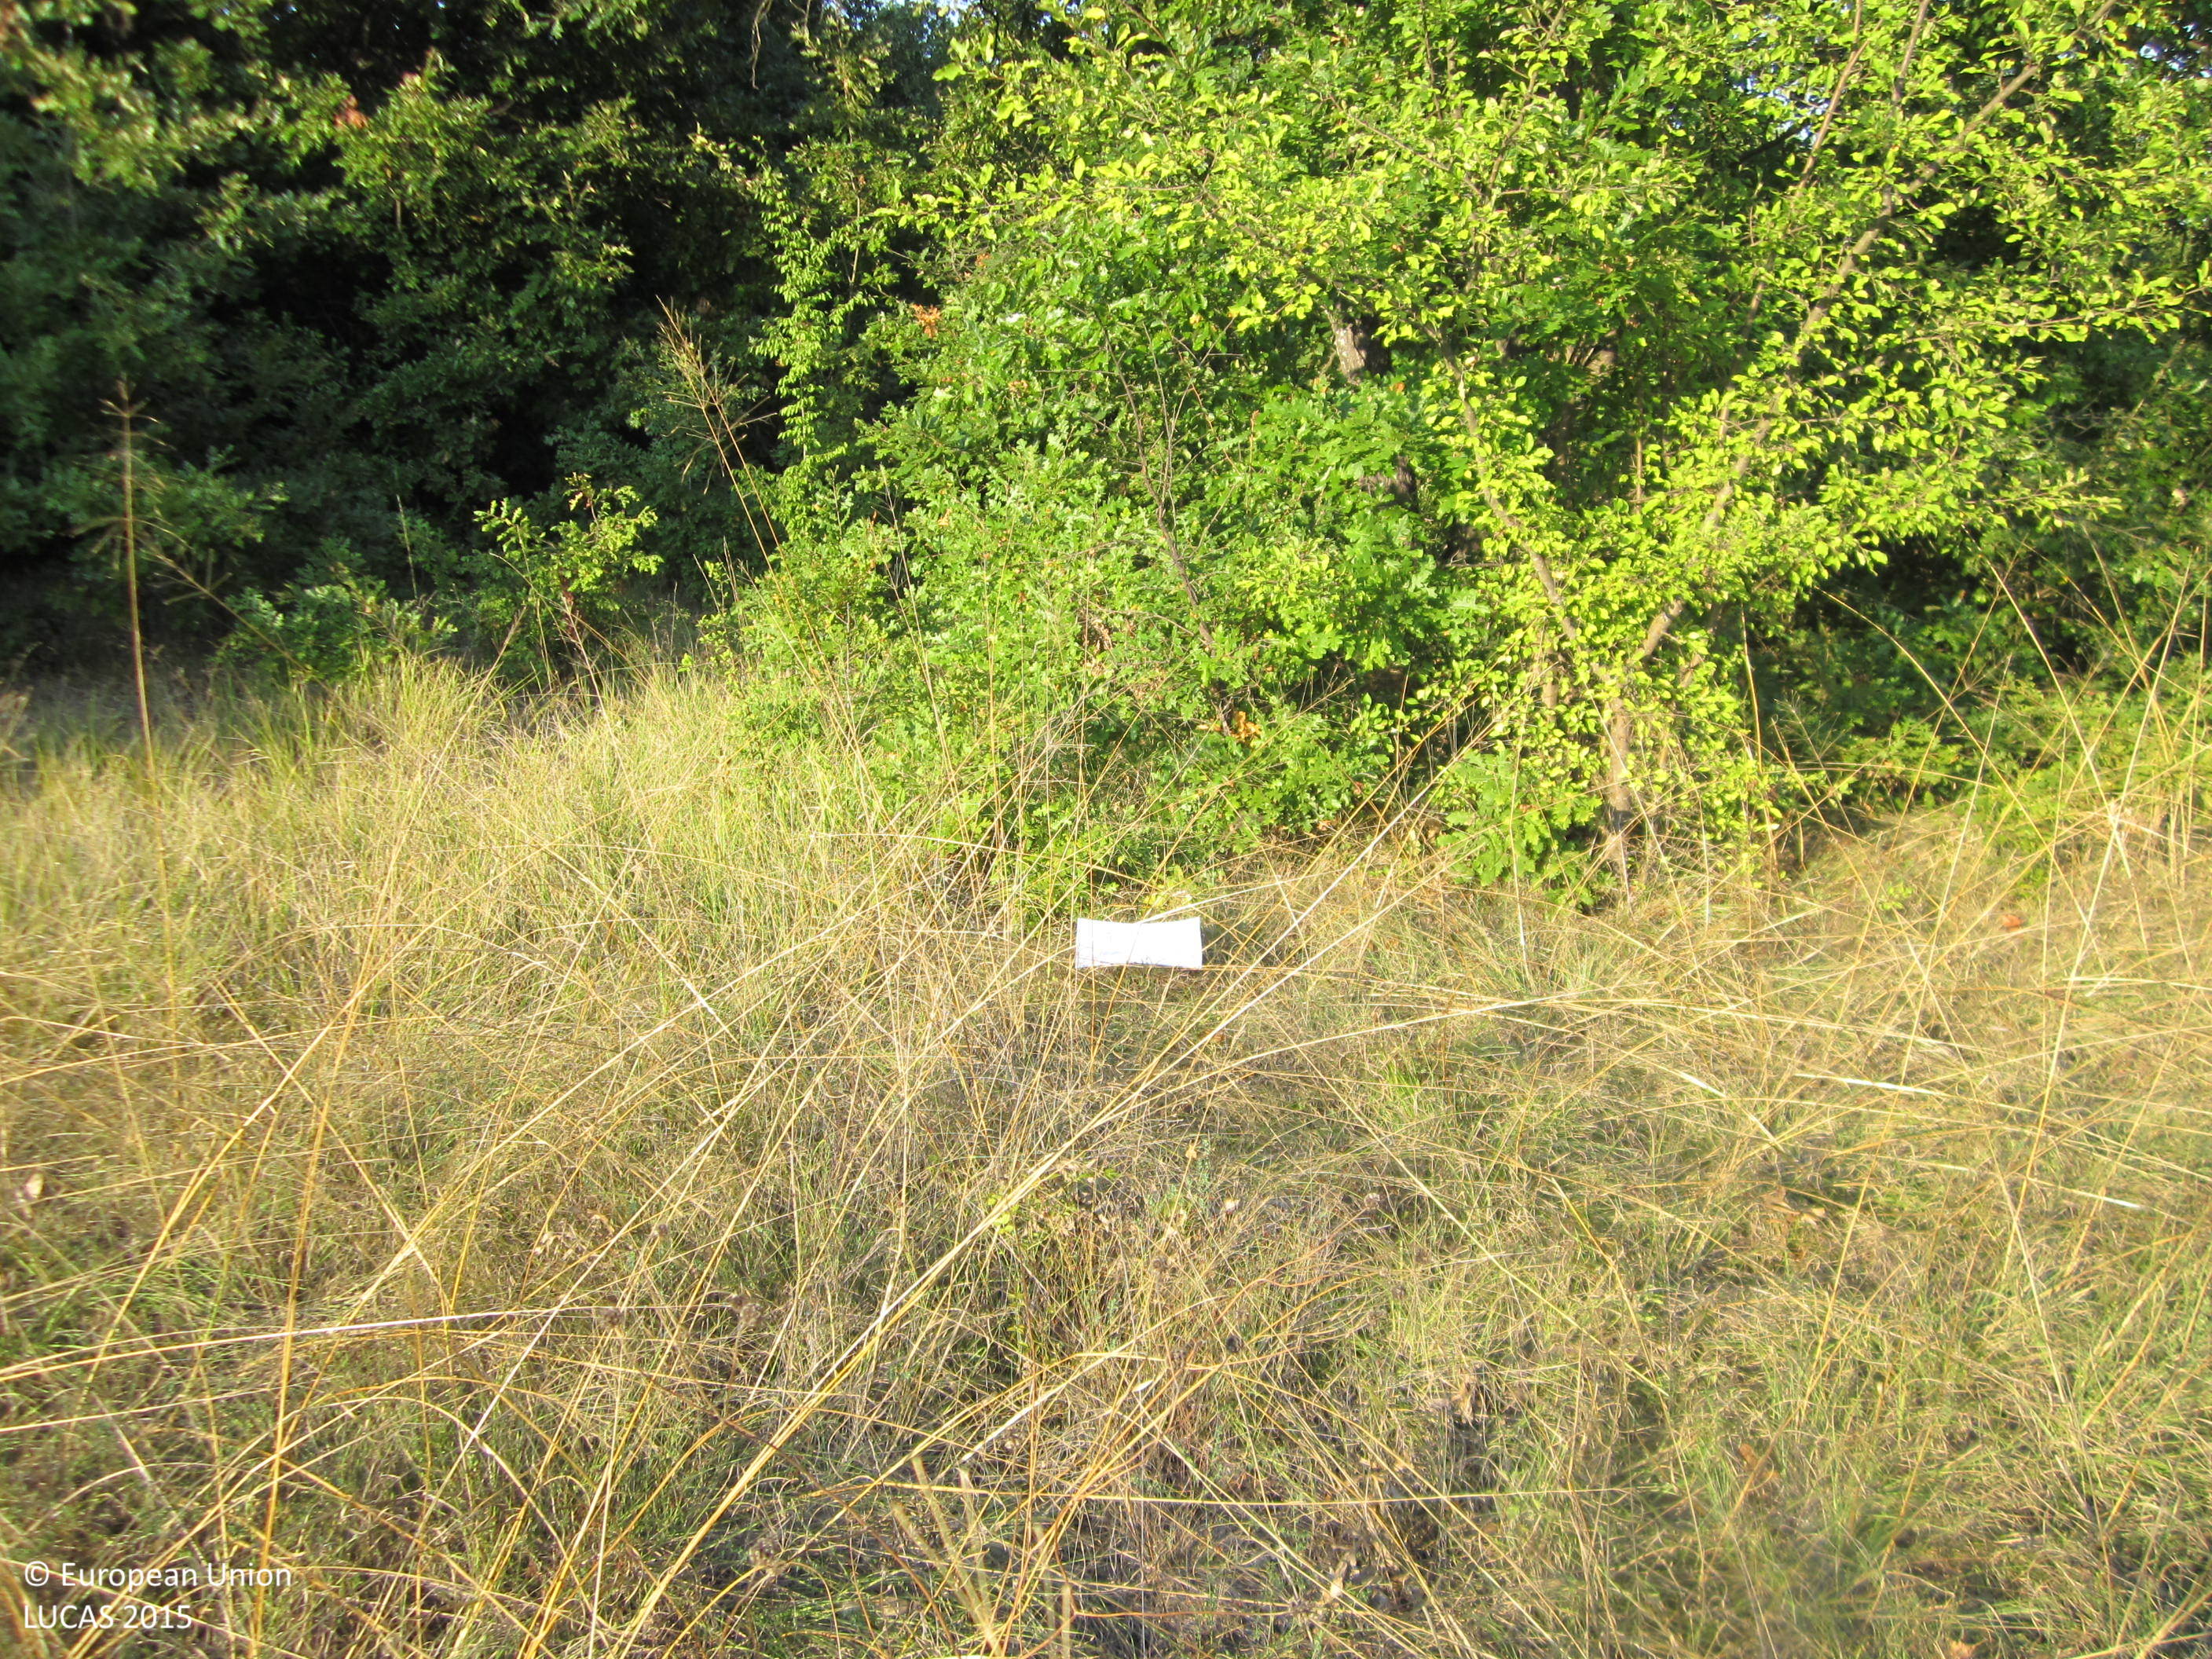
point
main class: Woodland
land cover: Broadleaved woodland
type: mesophytic deciduous forest
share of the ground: 25 - 50 %
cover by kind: herbaceous plants 60 %, broadleaved forest trees 35 %, shrubs 5 %
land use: Semi-natural and natural areas not in use
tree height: > 5 m
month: September
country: BG
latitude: 42.8392
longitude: 27.1312
